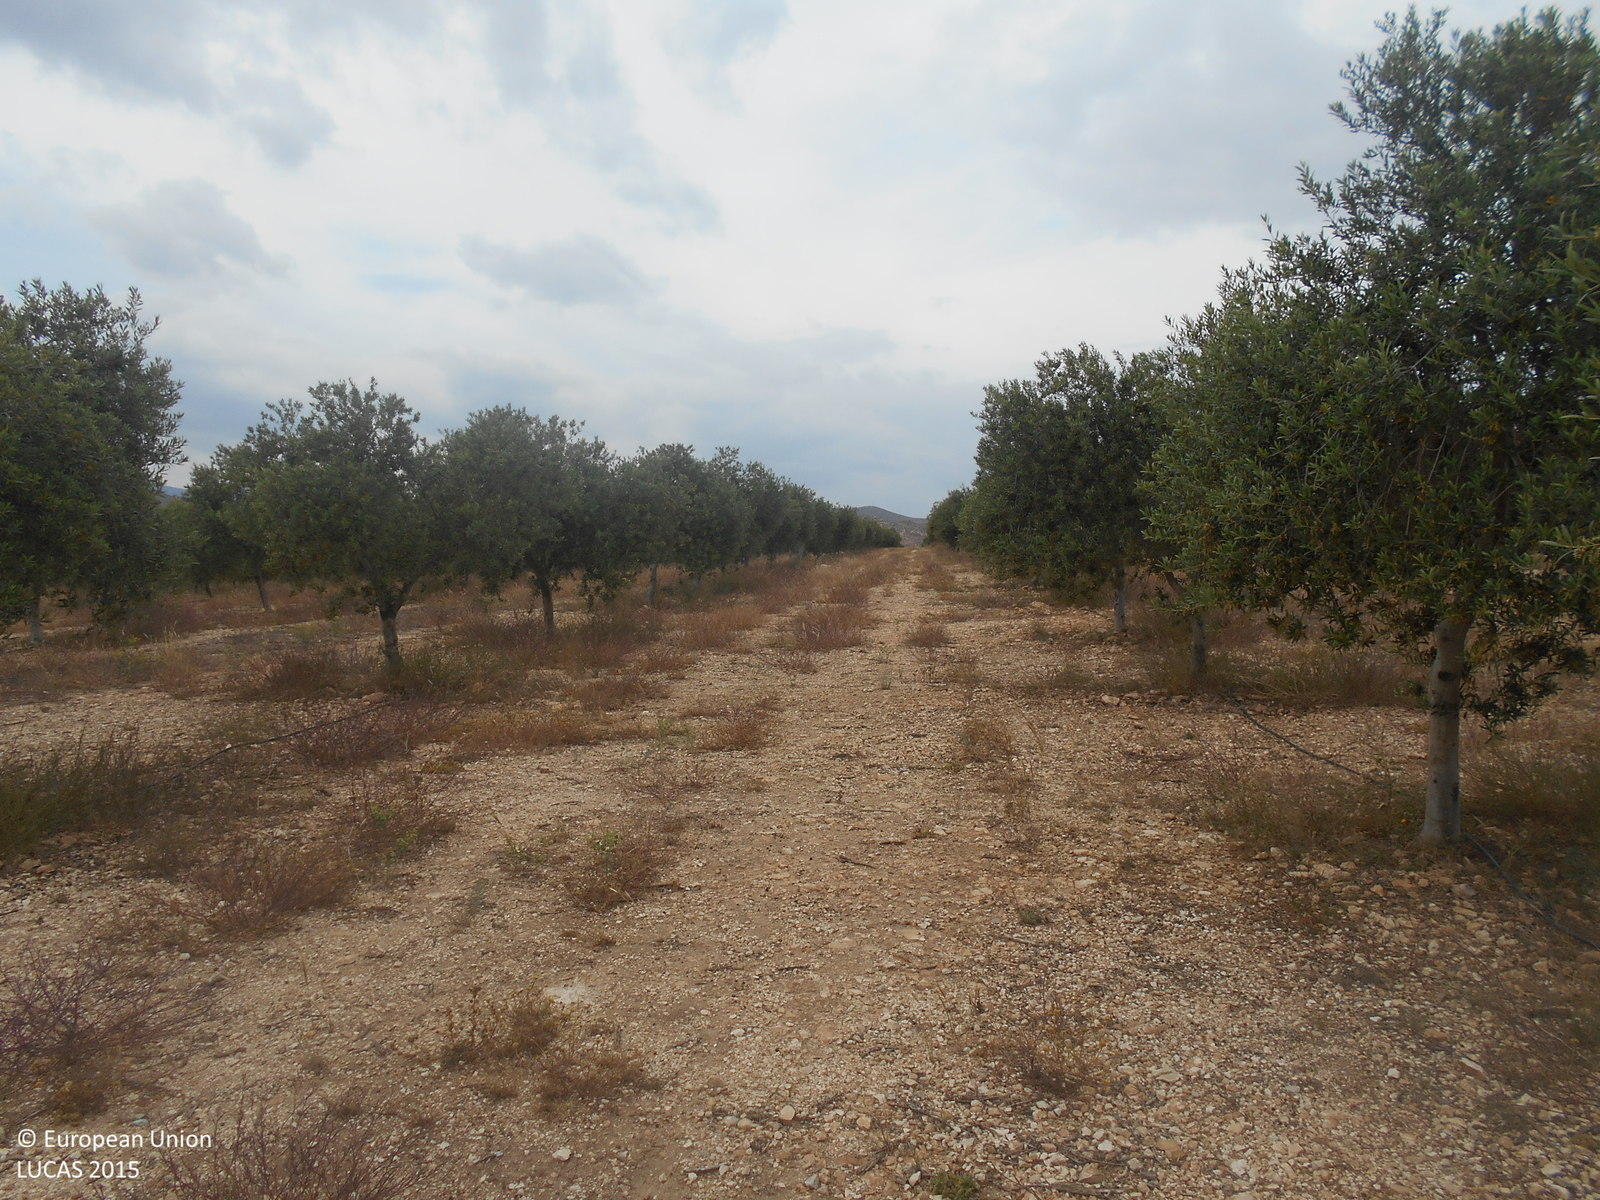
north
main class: Cropland
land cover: Olive groves
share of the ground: 25 - 50 %
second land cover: Spontaneously vegetated surfaces
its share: 10 - 25 %
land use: Agriculture (excluding fallow land and kitchen gardens)
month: May
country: ES
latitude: 37.1135
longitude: -2.2785
